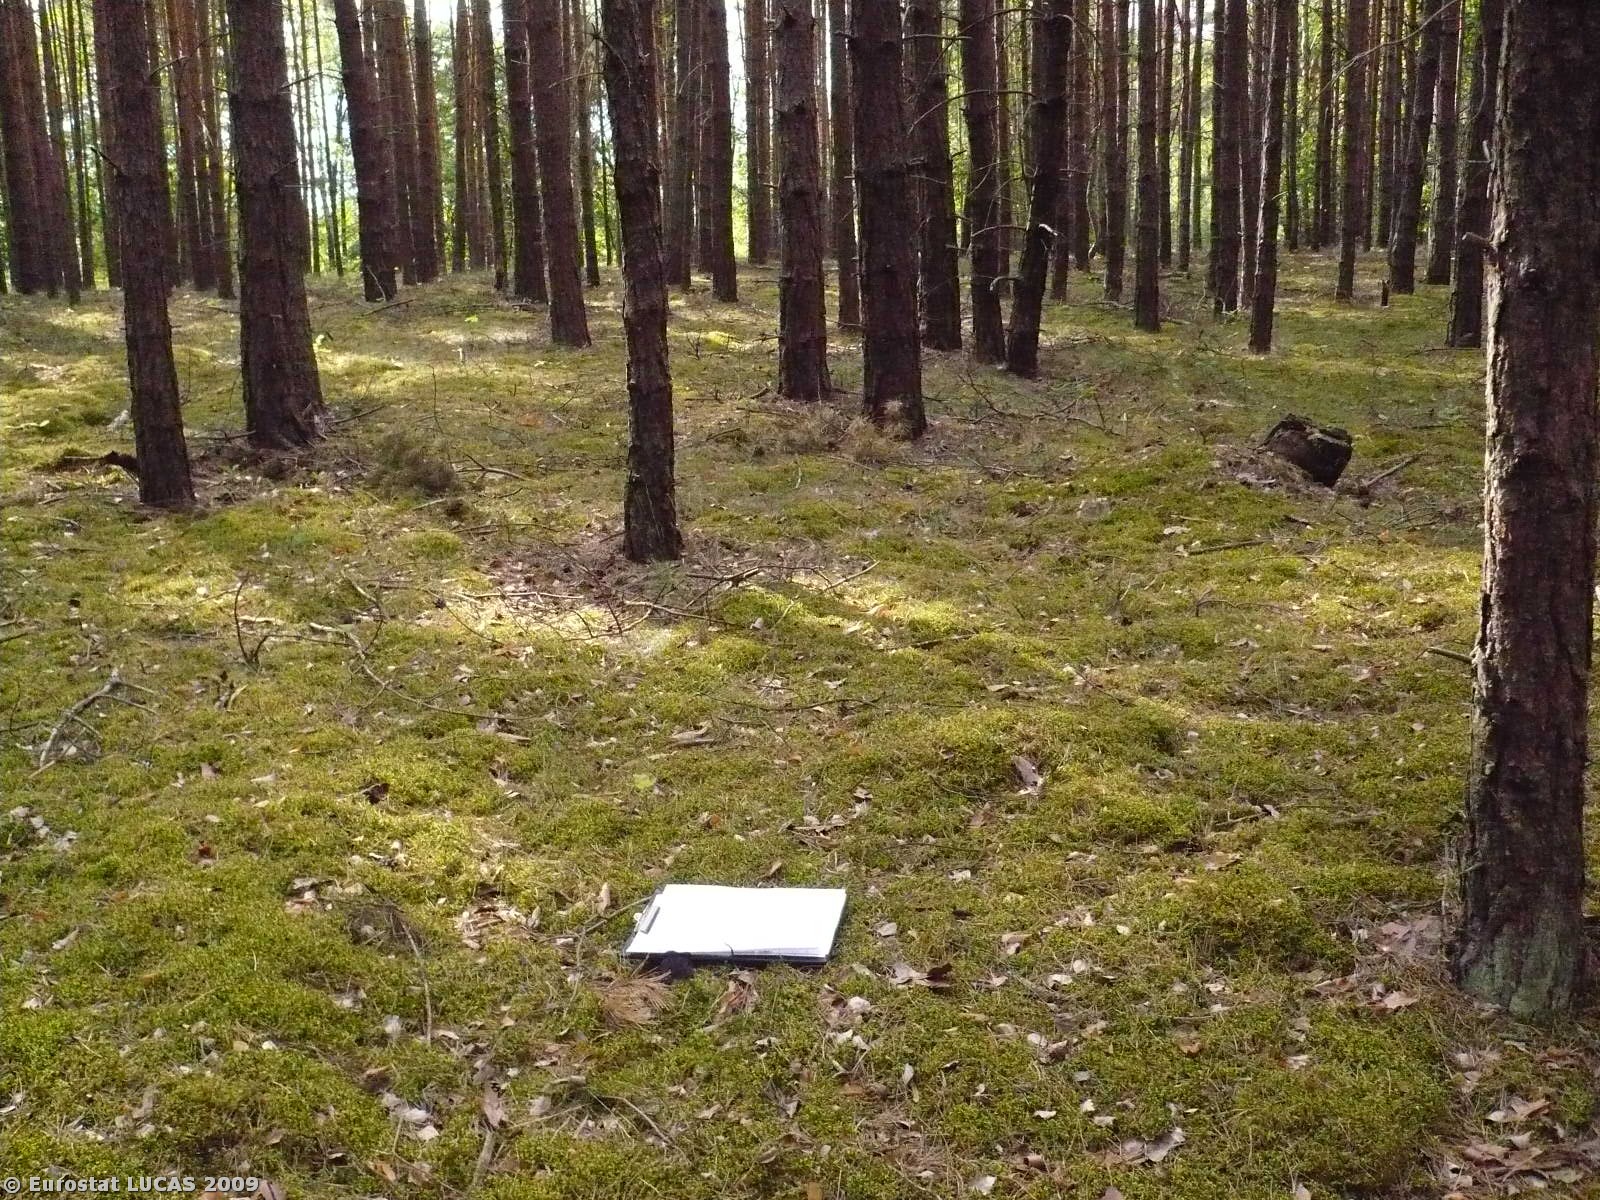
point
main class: Woodland
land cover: Coniferous woodland
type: hemiboreal forest and nemoral coniferous forest and mixed broadleaved-coniferous forest
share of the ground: > 75 %
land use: Forestry
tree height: > 5 m
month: May
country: PL
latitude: 52.0598
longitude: 15.3272
